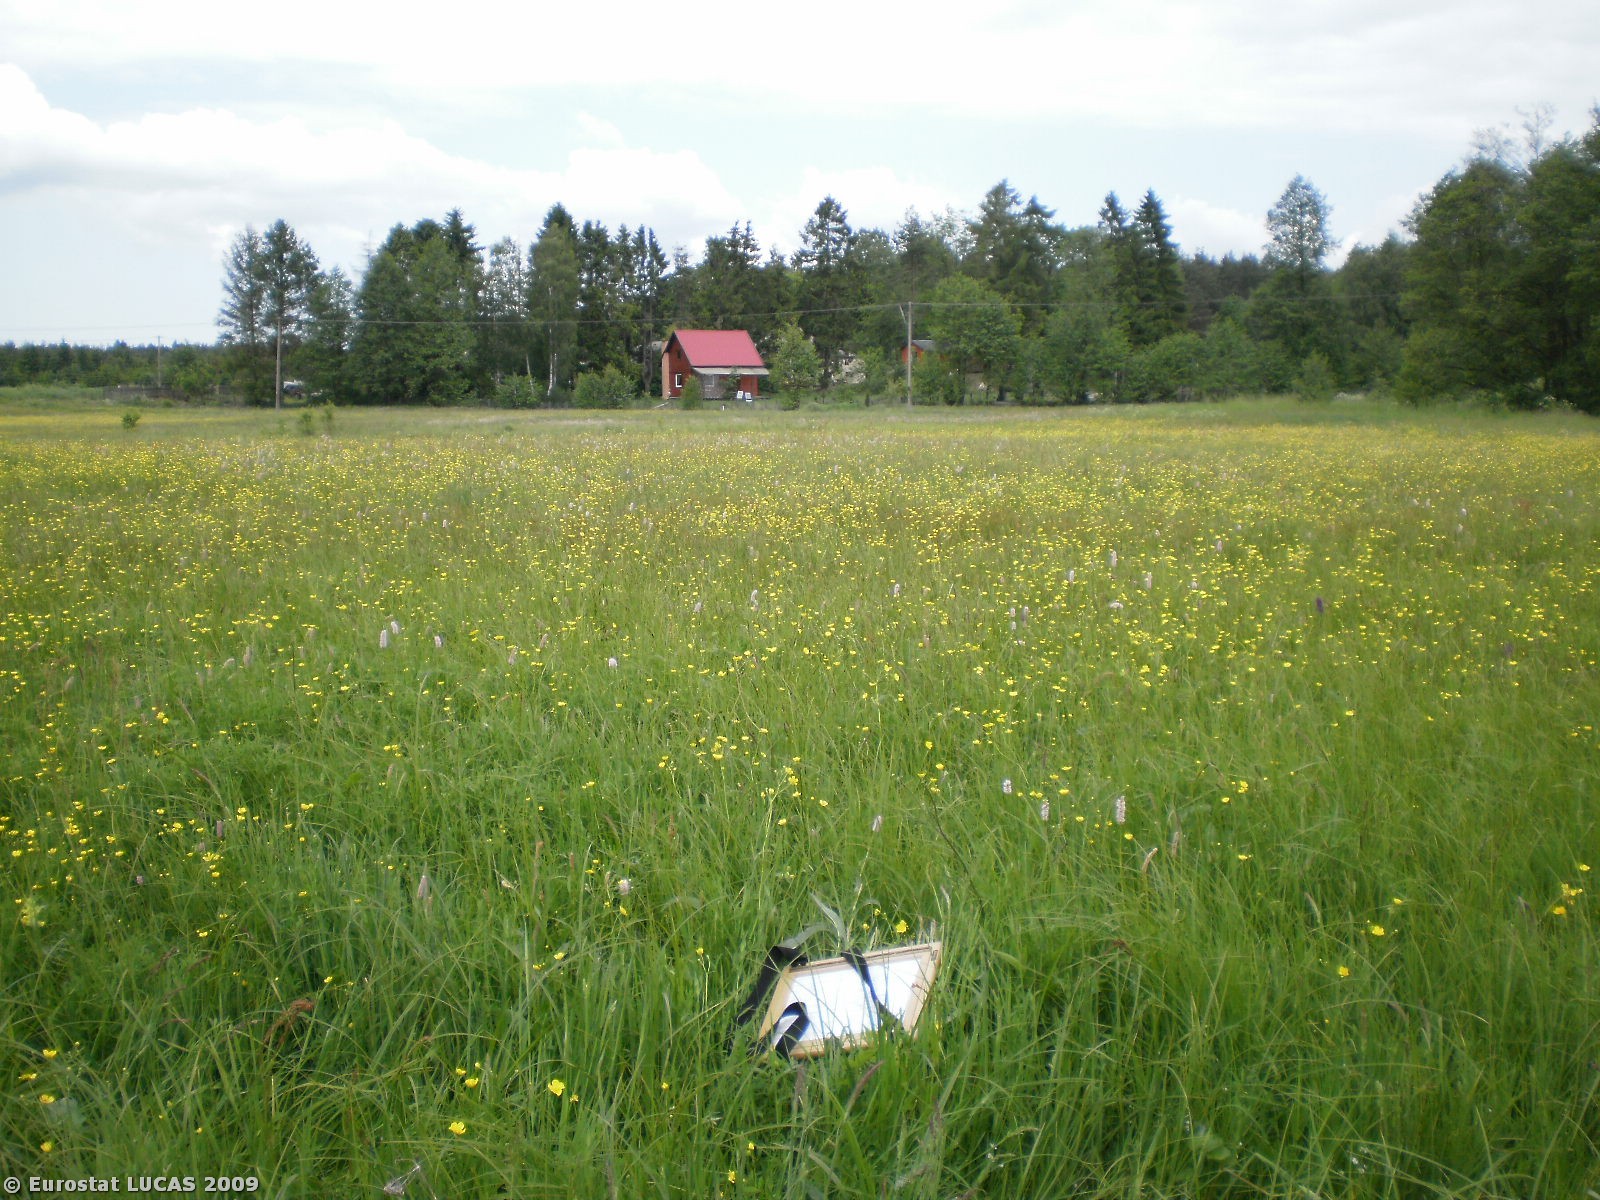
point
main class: Grassland
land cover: Grassland without tree/shrub cover
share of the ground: > 75 %
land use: Agriculture (excluding fallow land and kitchen gardens)
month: June
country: PL
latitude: 54.3932
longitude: 17.8519
